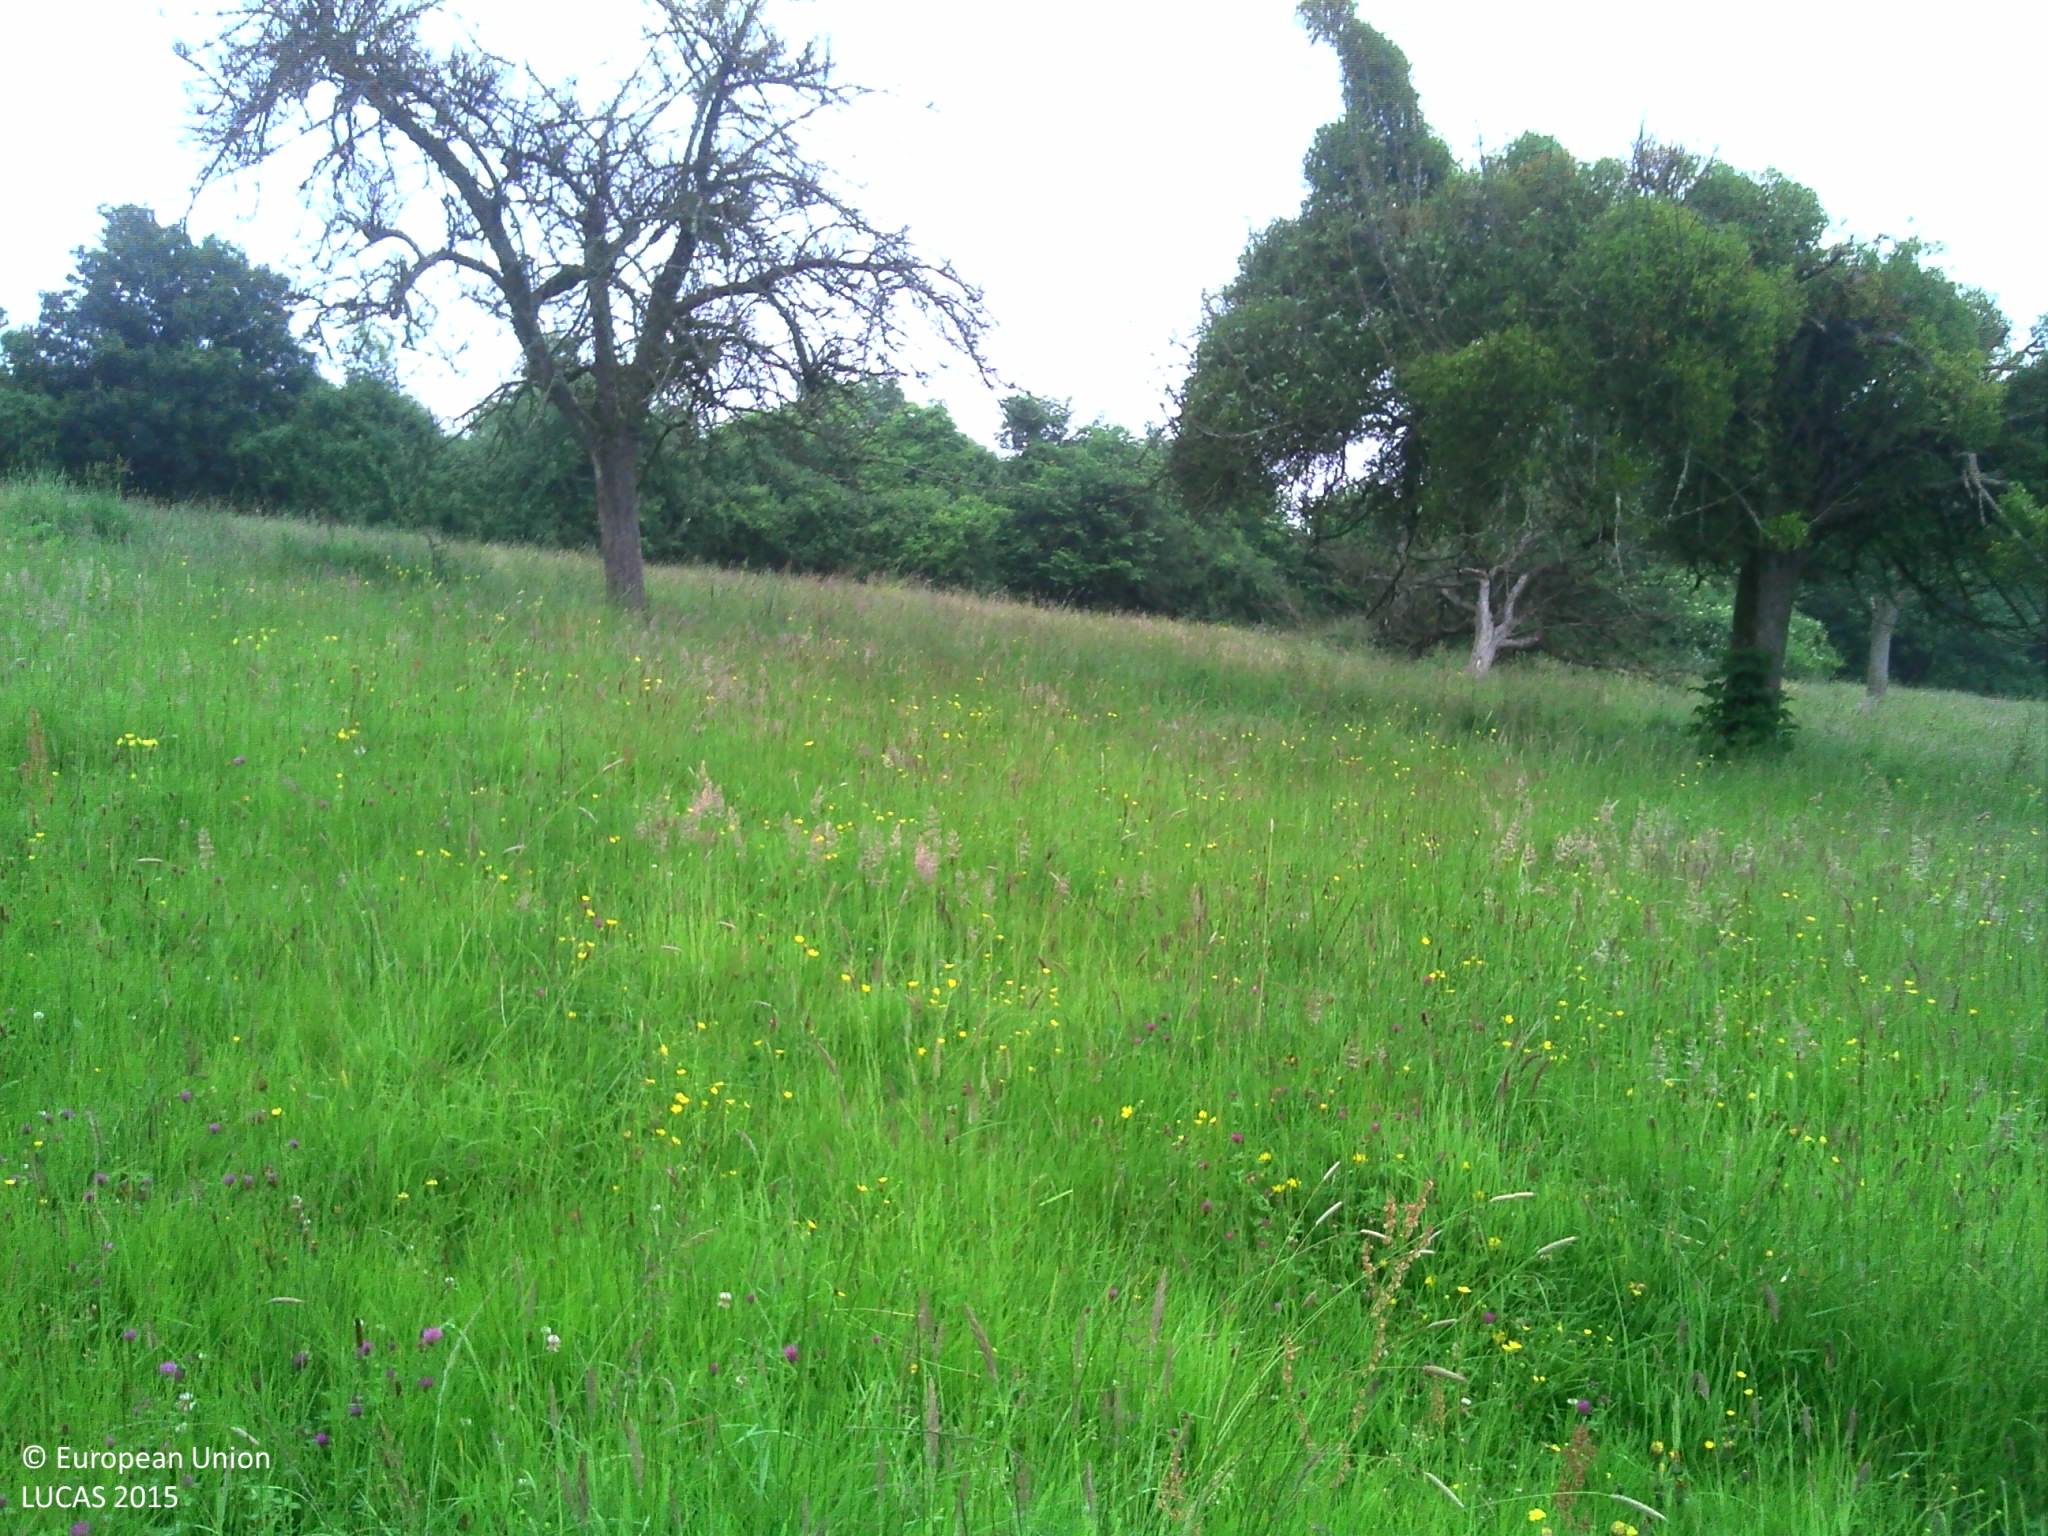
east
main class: Grassland
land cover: Grassland with sparse tree/shrub cover
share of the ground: > 75 %
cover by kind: herbaceous plants 95 %, broadleaved forest trees 5 %
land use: Agriculture (excluding fallow land and kitchen gardens)
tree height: > 5 m
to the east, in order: Grassland with sparse tree/shrub cover; Electric lines; Fences; Abandoned hedges; Grassland with sparse tree/shrub cover; Grassland without tree/shrub cover; Broadleaved woodland; Grassland without tree/shrub cover
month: June
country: FR
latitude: 49.2395
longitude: 0.0388
